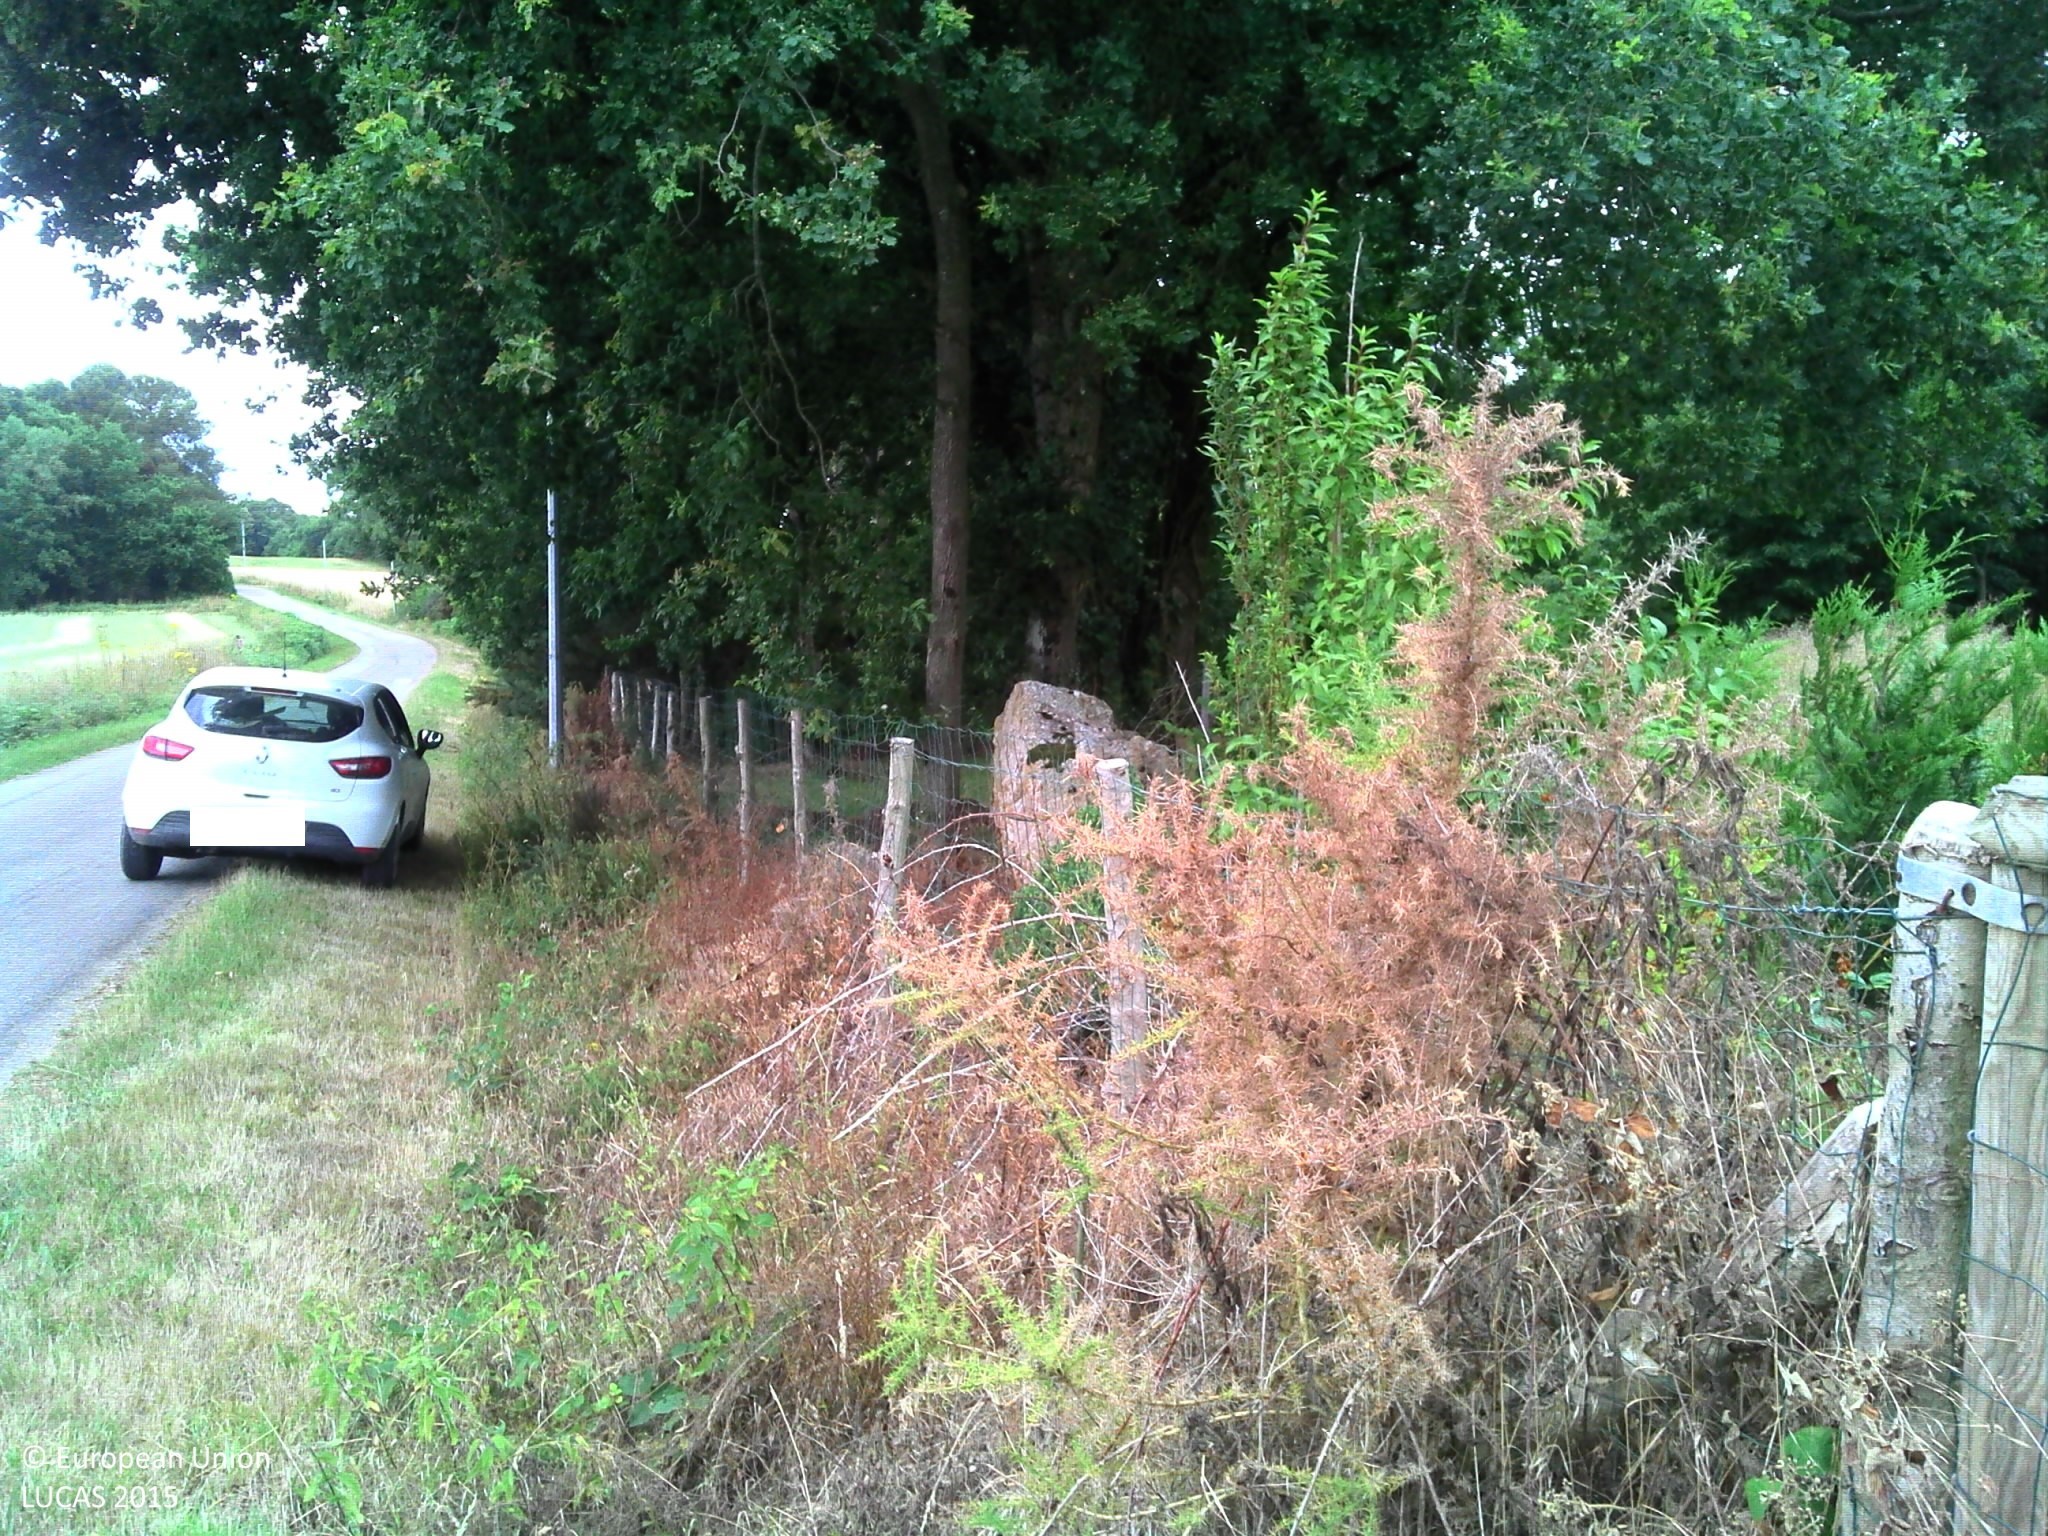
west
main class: Cropland
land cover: Apple fruit
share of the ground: 25 - 50 %
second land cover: Grassland without tree/shrub cover
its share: > 75 %
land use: Kitchen garden
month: July
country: FR
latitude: 47.8165
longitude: -2.0314
